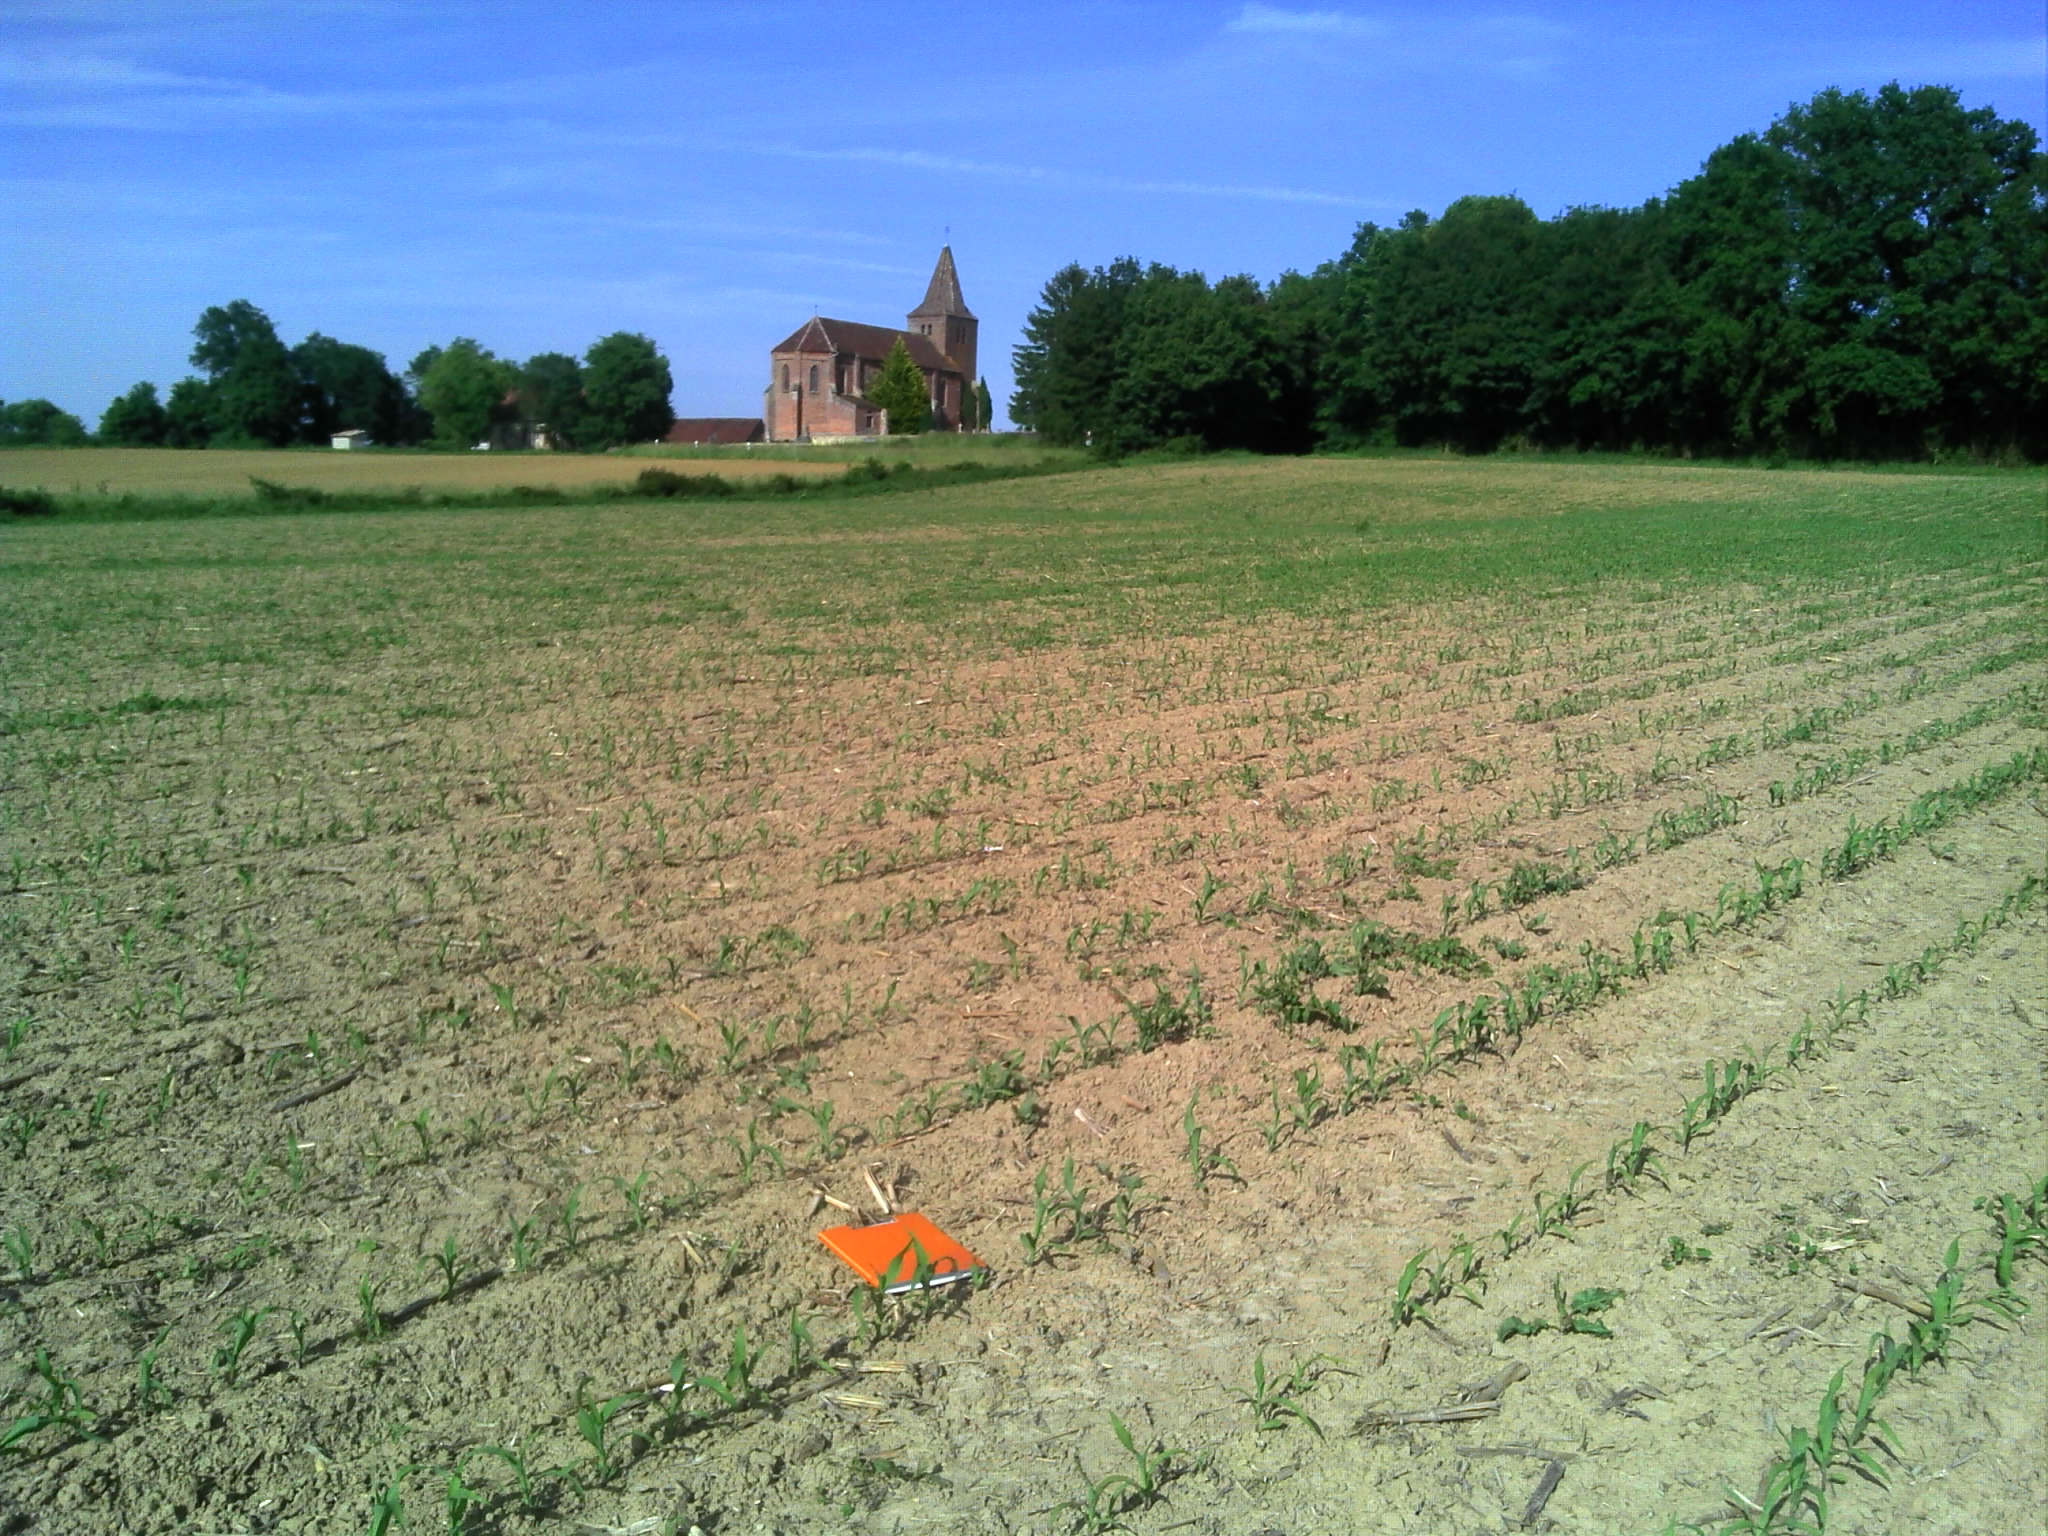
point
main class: Cropland
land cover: Maize
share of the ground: 10 - 25 %
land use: Agriculture (excluding fallow land and kitchen gardens)
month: May
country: FR
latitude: 46.5821
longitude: 5.1084
